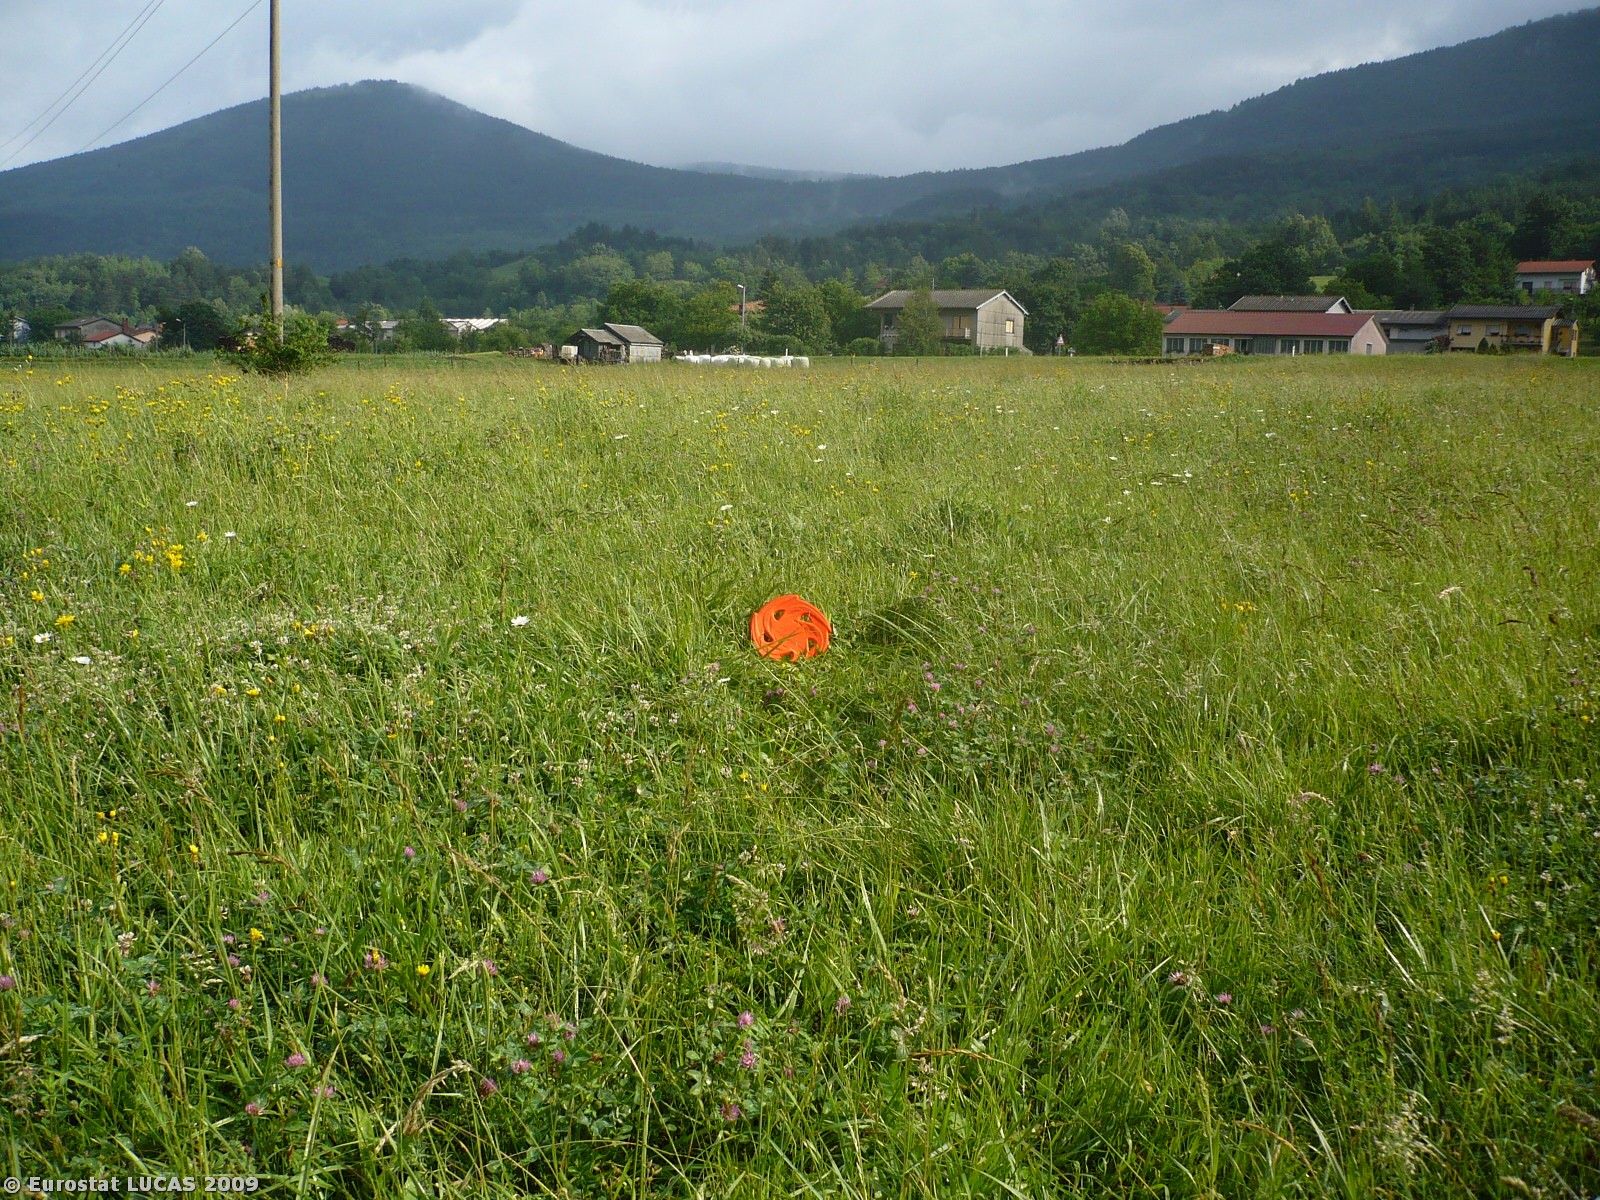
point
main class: Grassland
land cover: Grassland without tree/shrub cover
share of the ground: > 75 %
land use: Agriculture (excluding fallow land and kitchen gardens)
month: June
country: SI
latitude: 45.5437
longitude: 14.2859
